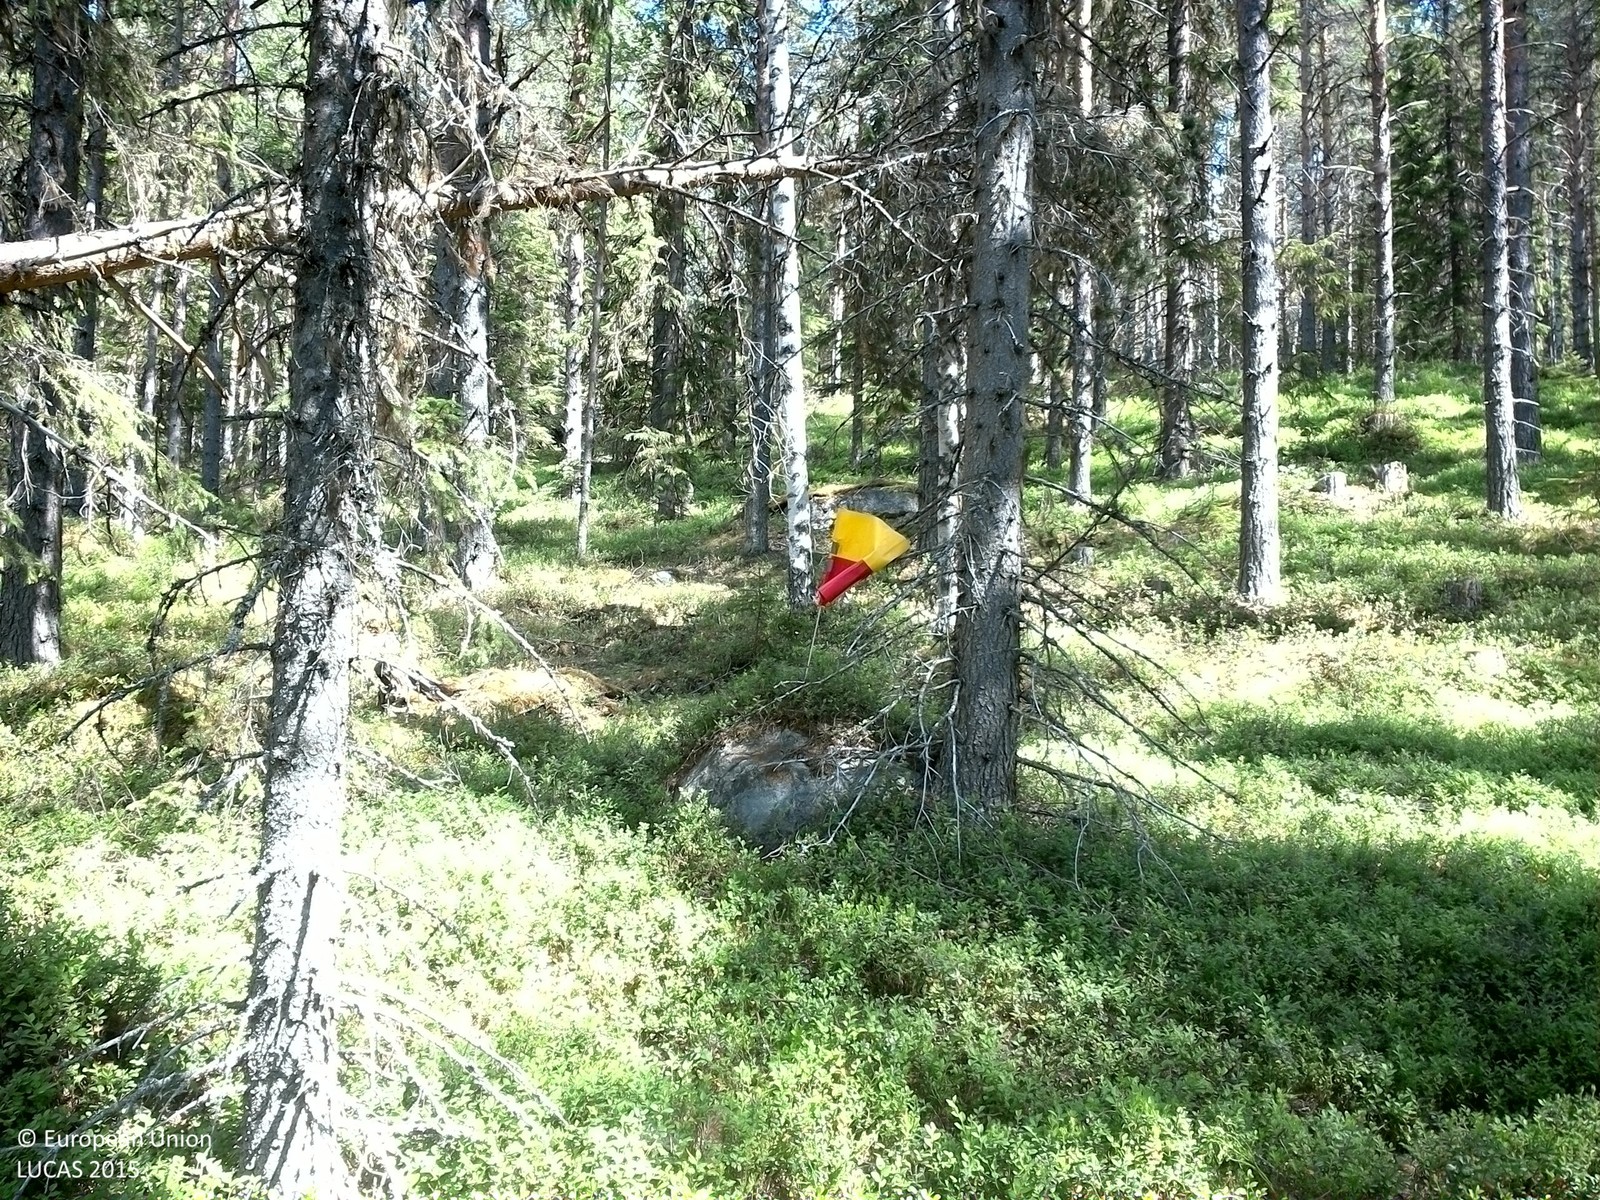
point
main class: Woodland
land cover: Pine dominated coniferous woodland
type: boreal forest
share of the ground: 50 - 75 %
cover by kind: coniferous forest trees 60 %, shrubs 25 %, lichens and mosses 10 %, broadleaved forest trees 5 %
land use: Forestry
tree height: > 5 m
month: July
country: SE
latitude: 64.2327
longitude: 16.8348
